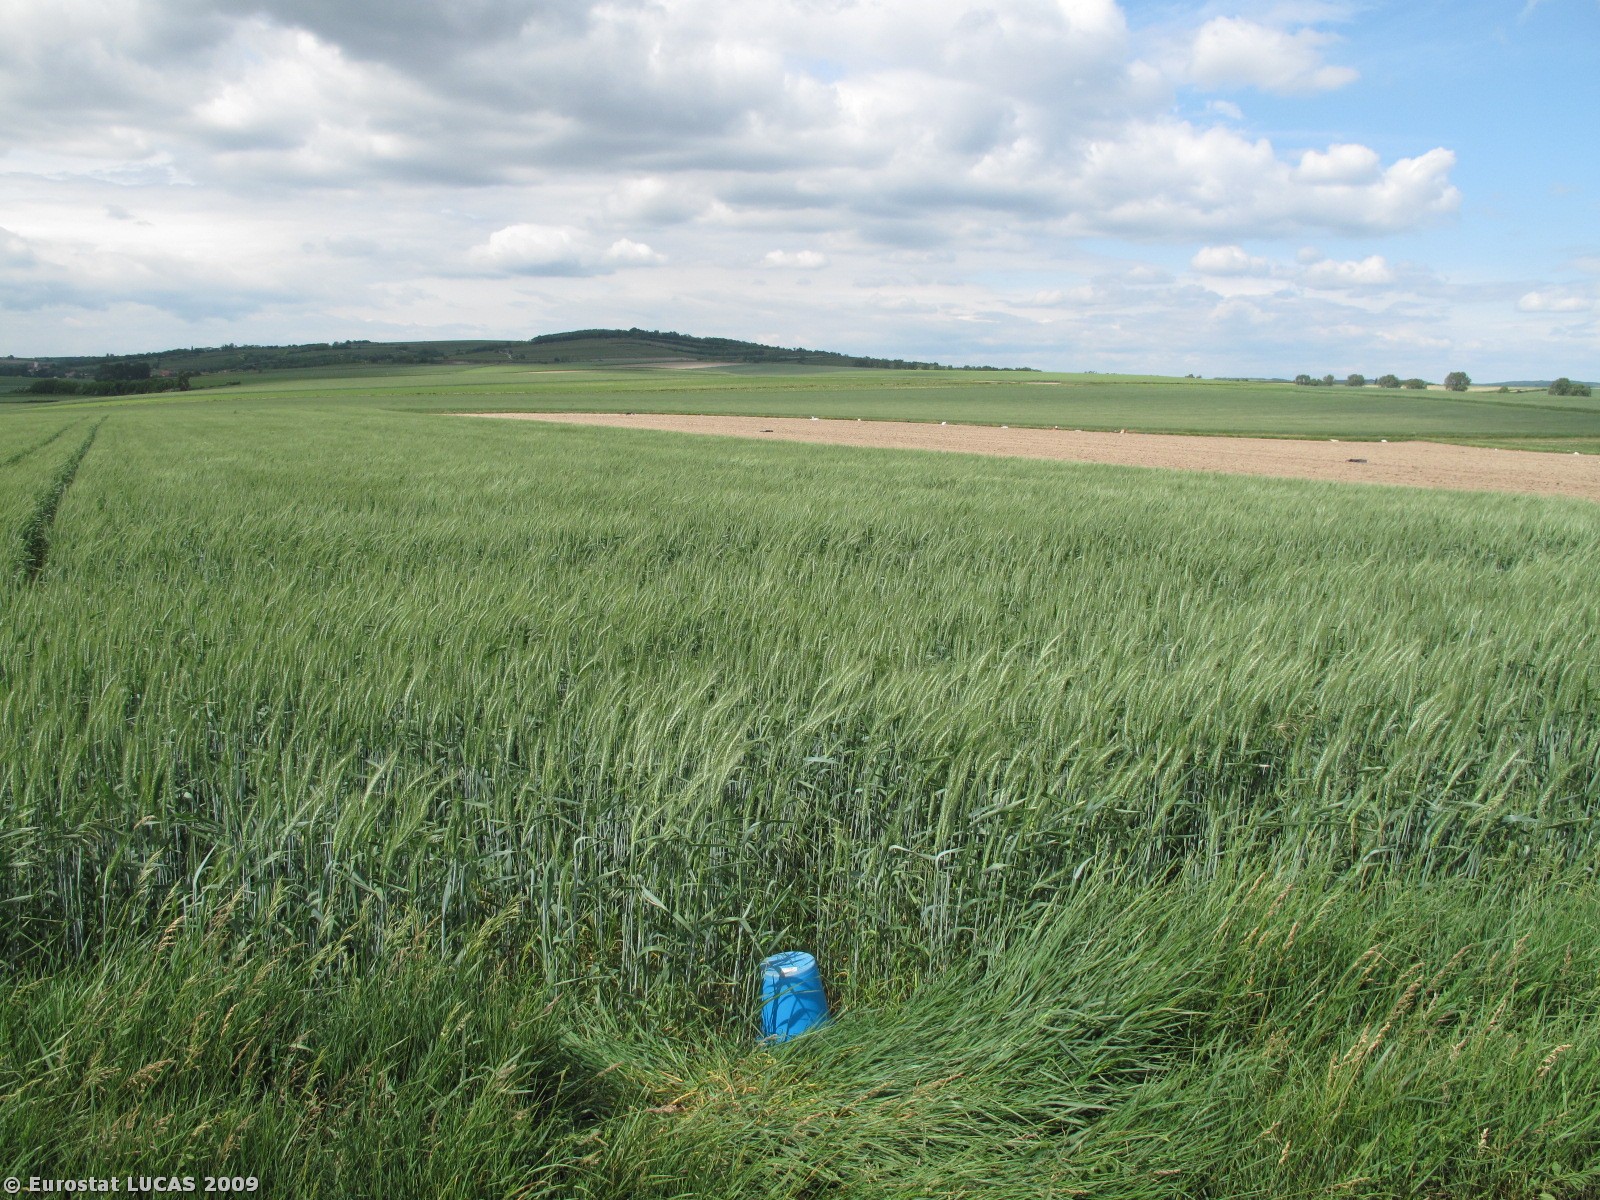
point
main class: Cropland
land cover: Triticale
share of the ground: > 75 %
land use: Agriculture (excluding fallow land and kitchen gardens)
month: May
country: AT
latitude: 48.4409
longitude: 15.9655
